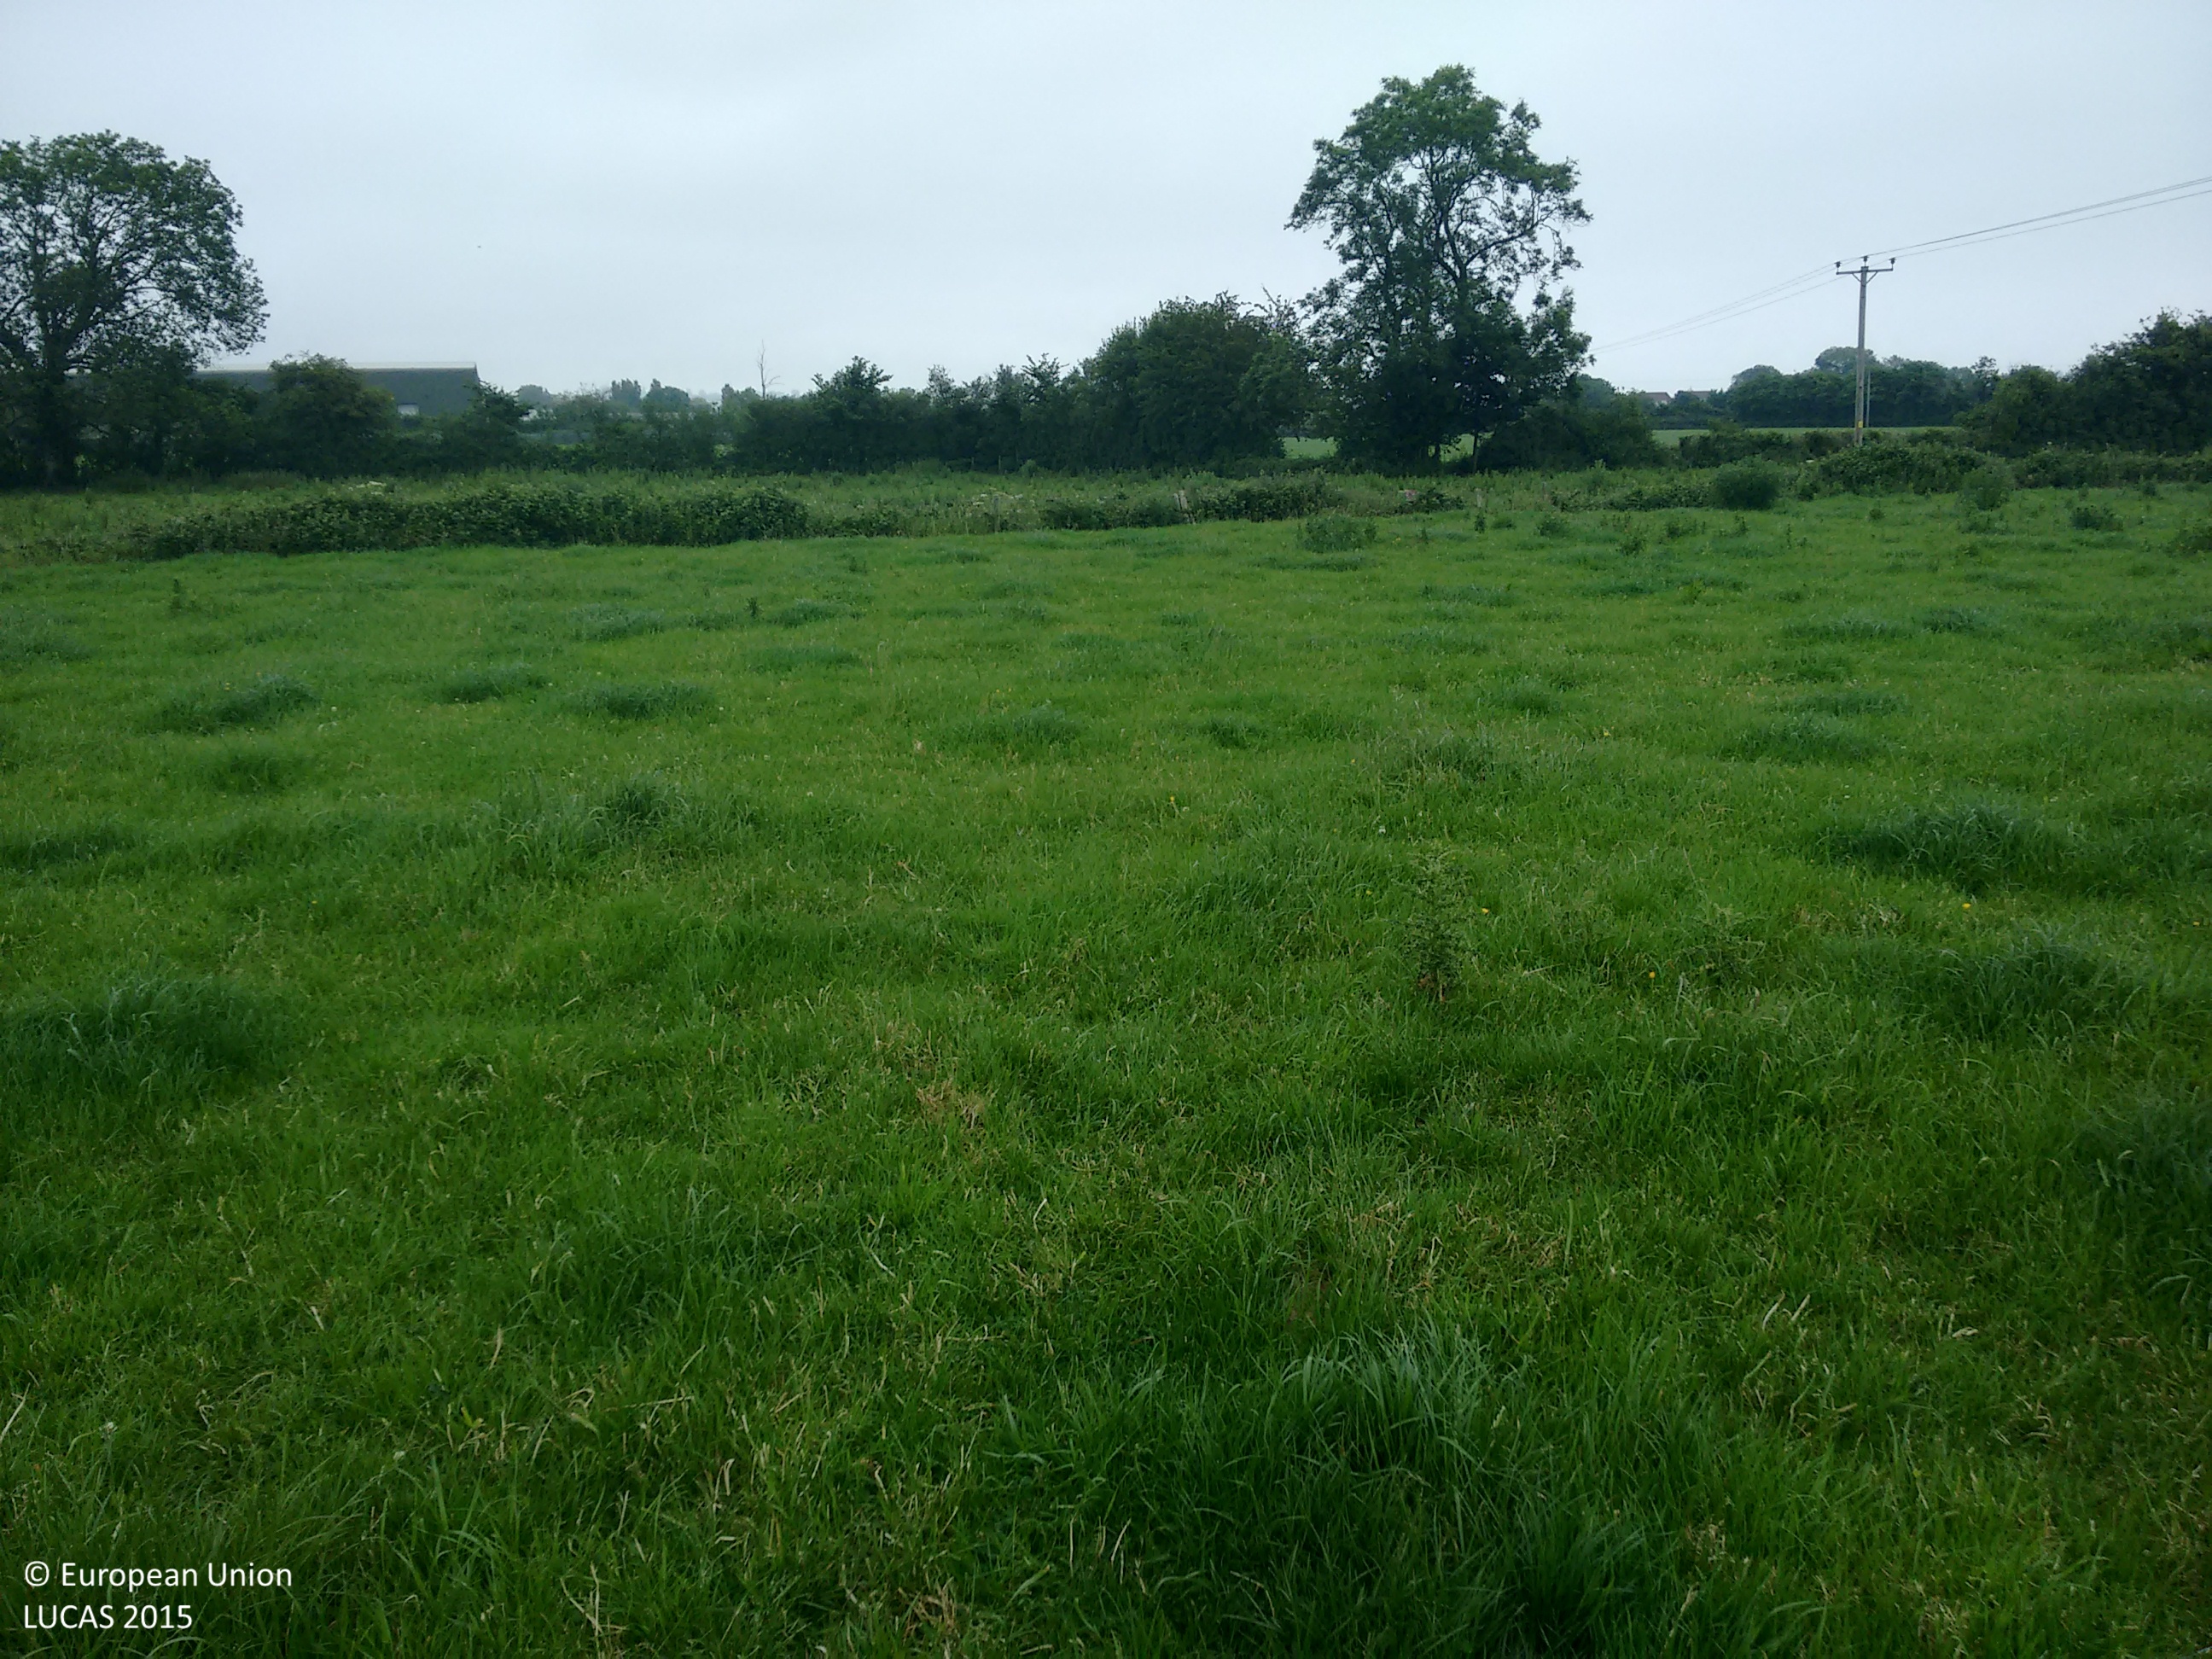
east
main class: Grassland
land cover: Grassland without tree/shrub cover
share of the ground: > 75 %
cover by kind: herbaceous plants 100 %
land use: Agriculture (excluding fallow land and kitchen gardens)
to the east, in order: Grassland without tree/shrub cover; Fences; Shruby margins; Rivers and streams; Shruby margins; Fences; Grassland without tree/shrub cover; Fences; Broadleaved woodland; Ditches and canals; Broadleaved woodland; Temporary grasslands
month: June
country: GB
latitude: 51.1474
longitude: -2.5177
